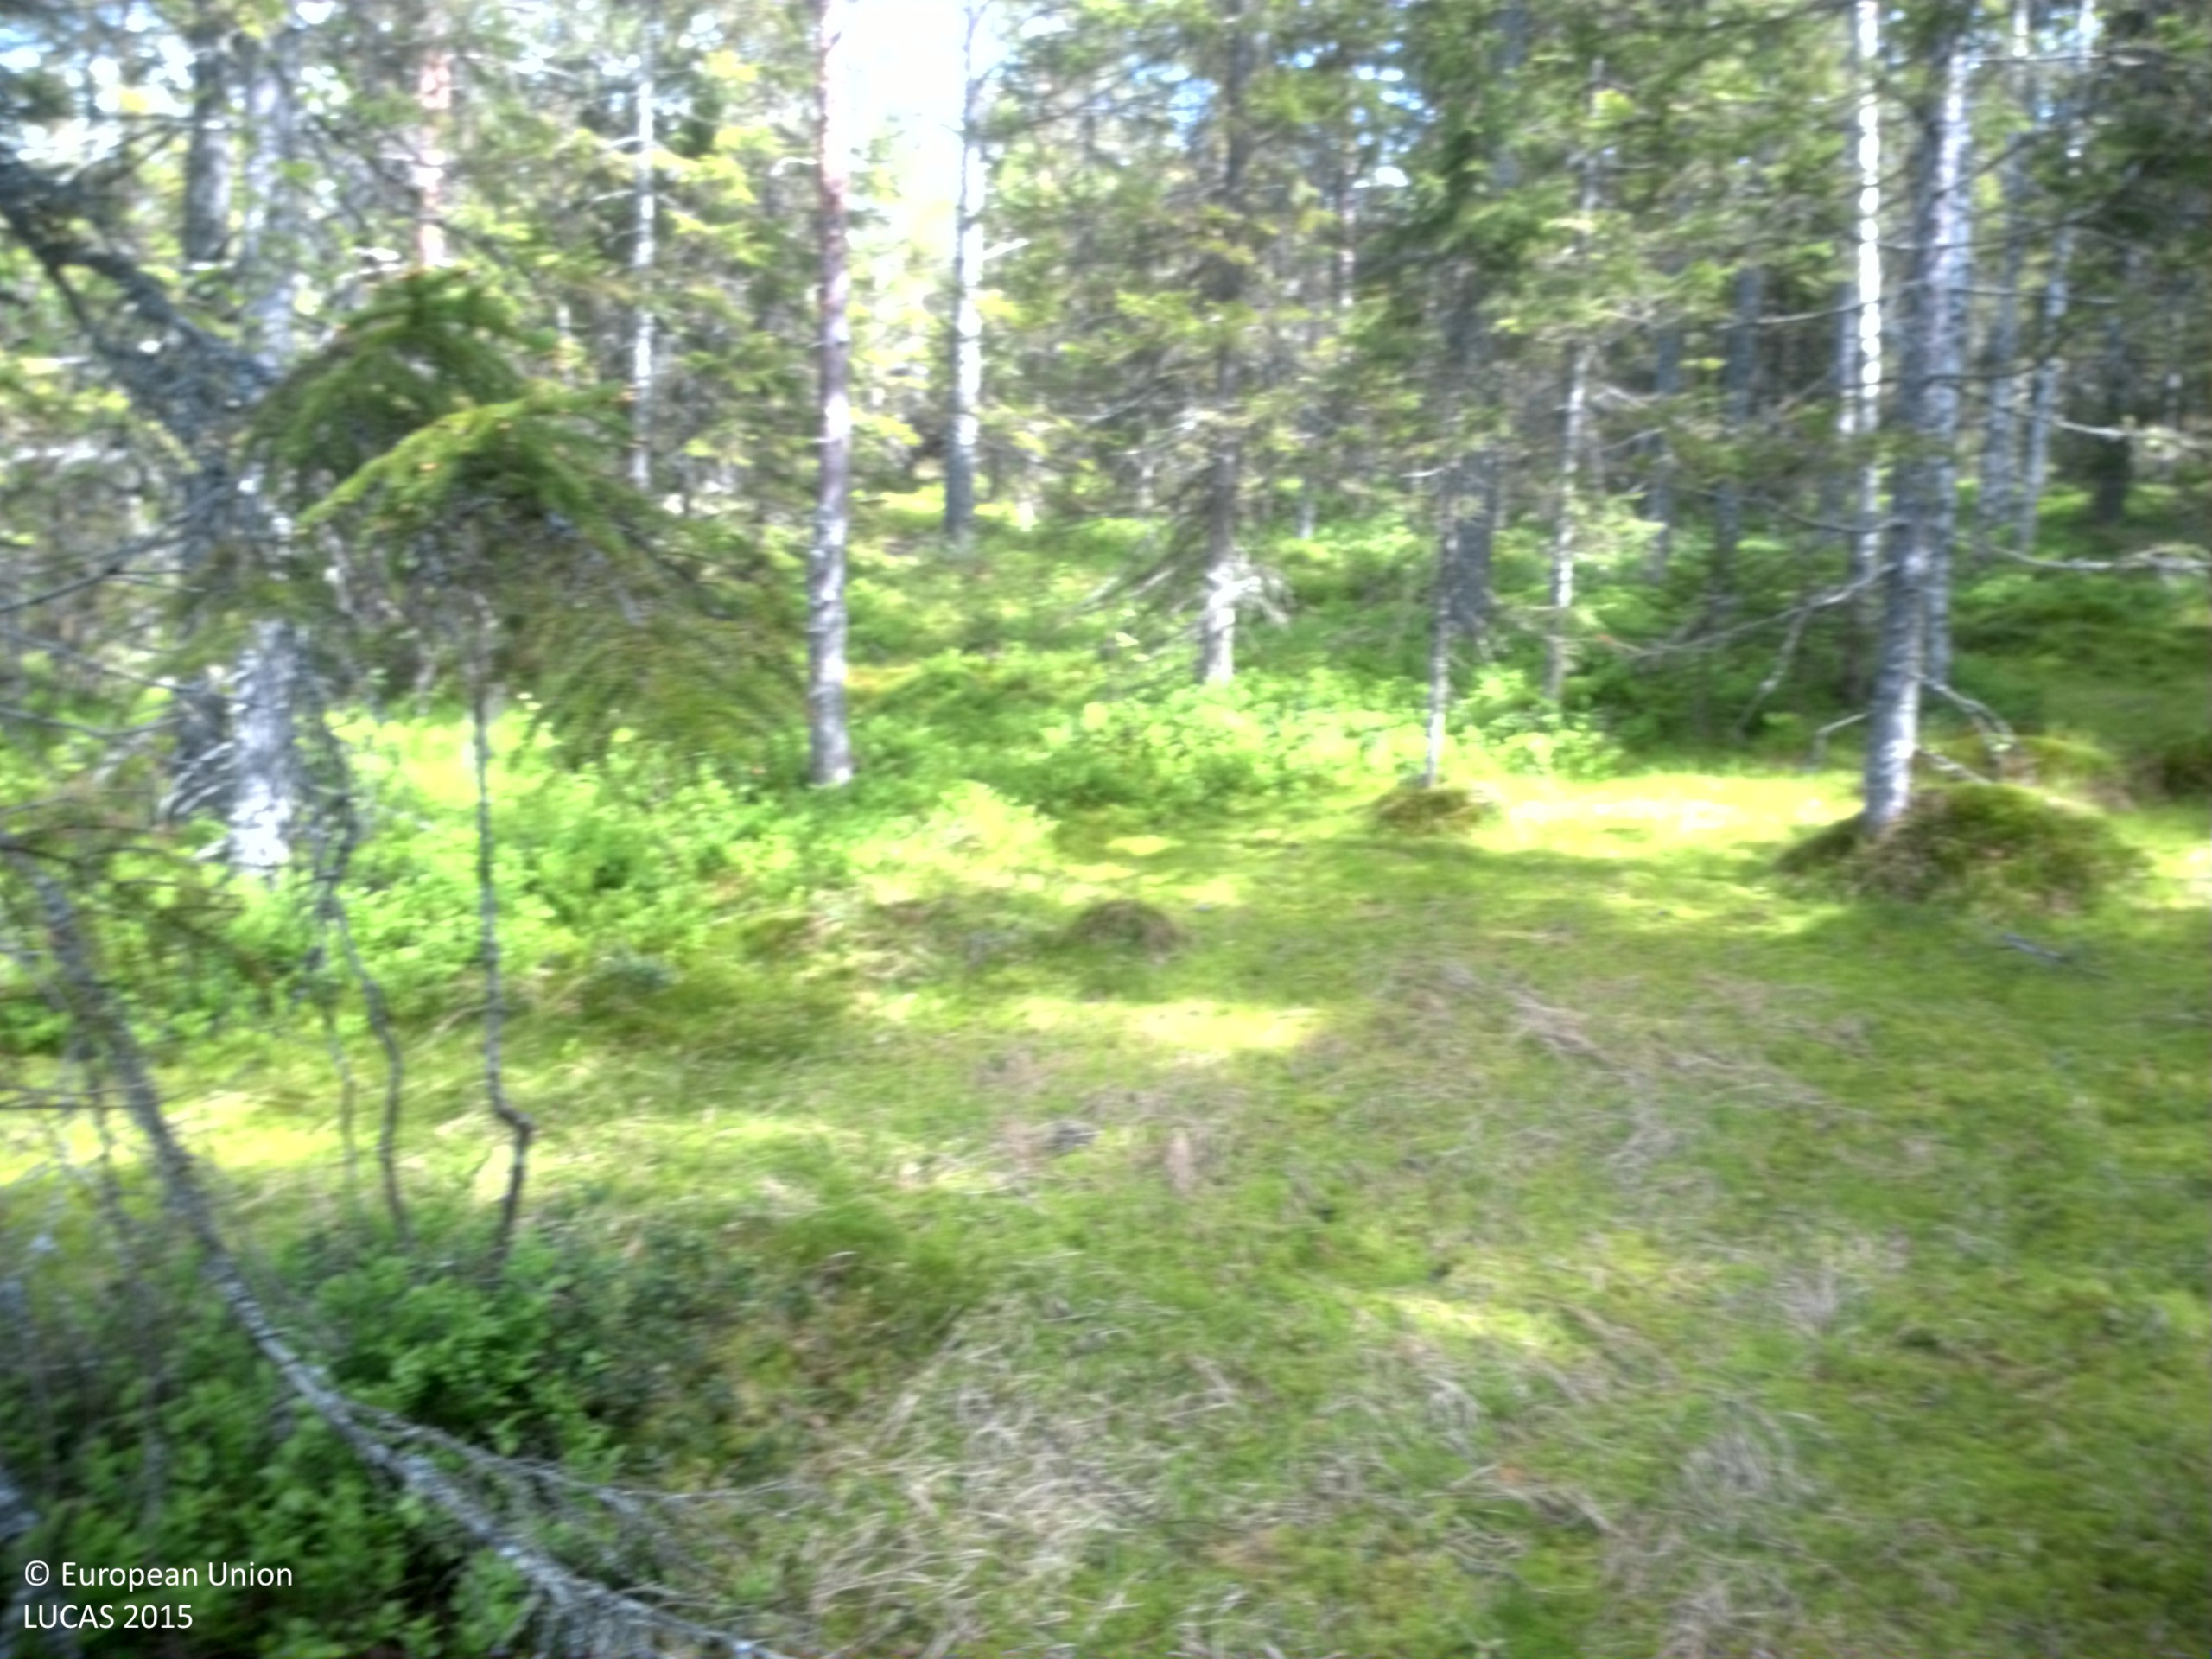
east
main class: Woodland
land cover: Spruce dominated mixed woodland
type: boreal forest
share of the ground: 50 - 75 %
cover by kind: coniferous forest trees 45 %, lichens and mosses 30 %, broadleaved forest trees 15 %, shrubs 10 %
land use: Forestry
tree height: > 5 m
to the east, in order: Spruce dominated mixed woodland; Pine dominated coniferous woodland; Rocks and stones; Pine dominated coniferous woodland; Spruce dominated coniferous woodland
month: June
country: SE
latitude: 62.9080
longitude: 17.9892
